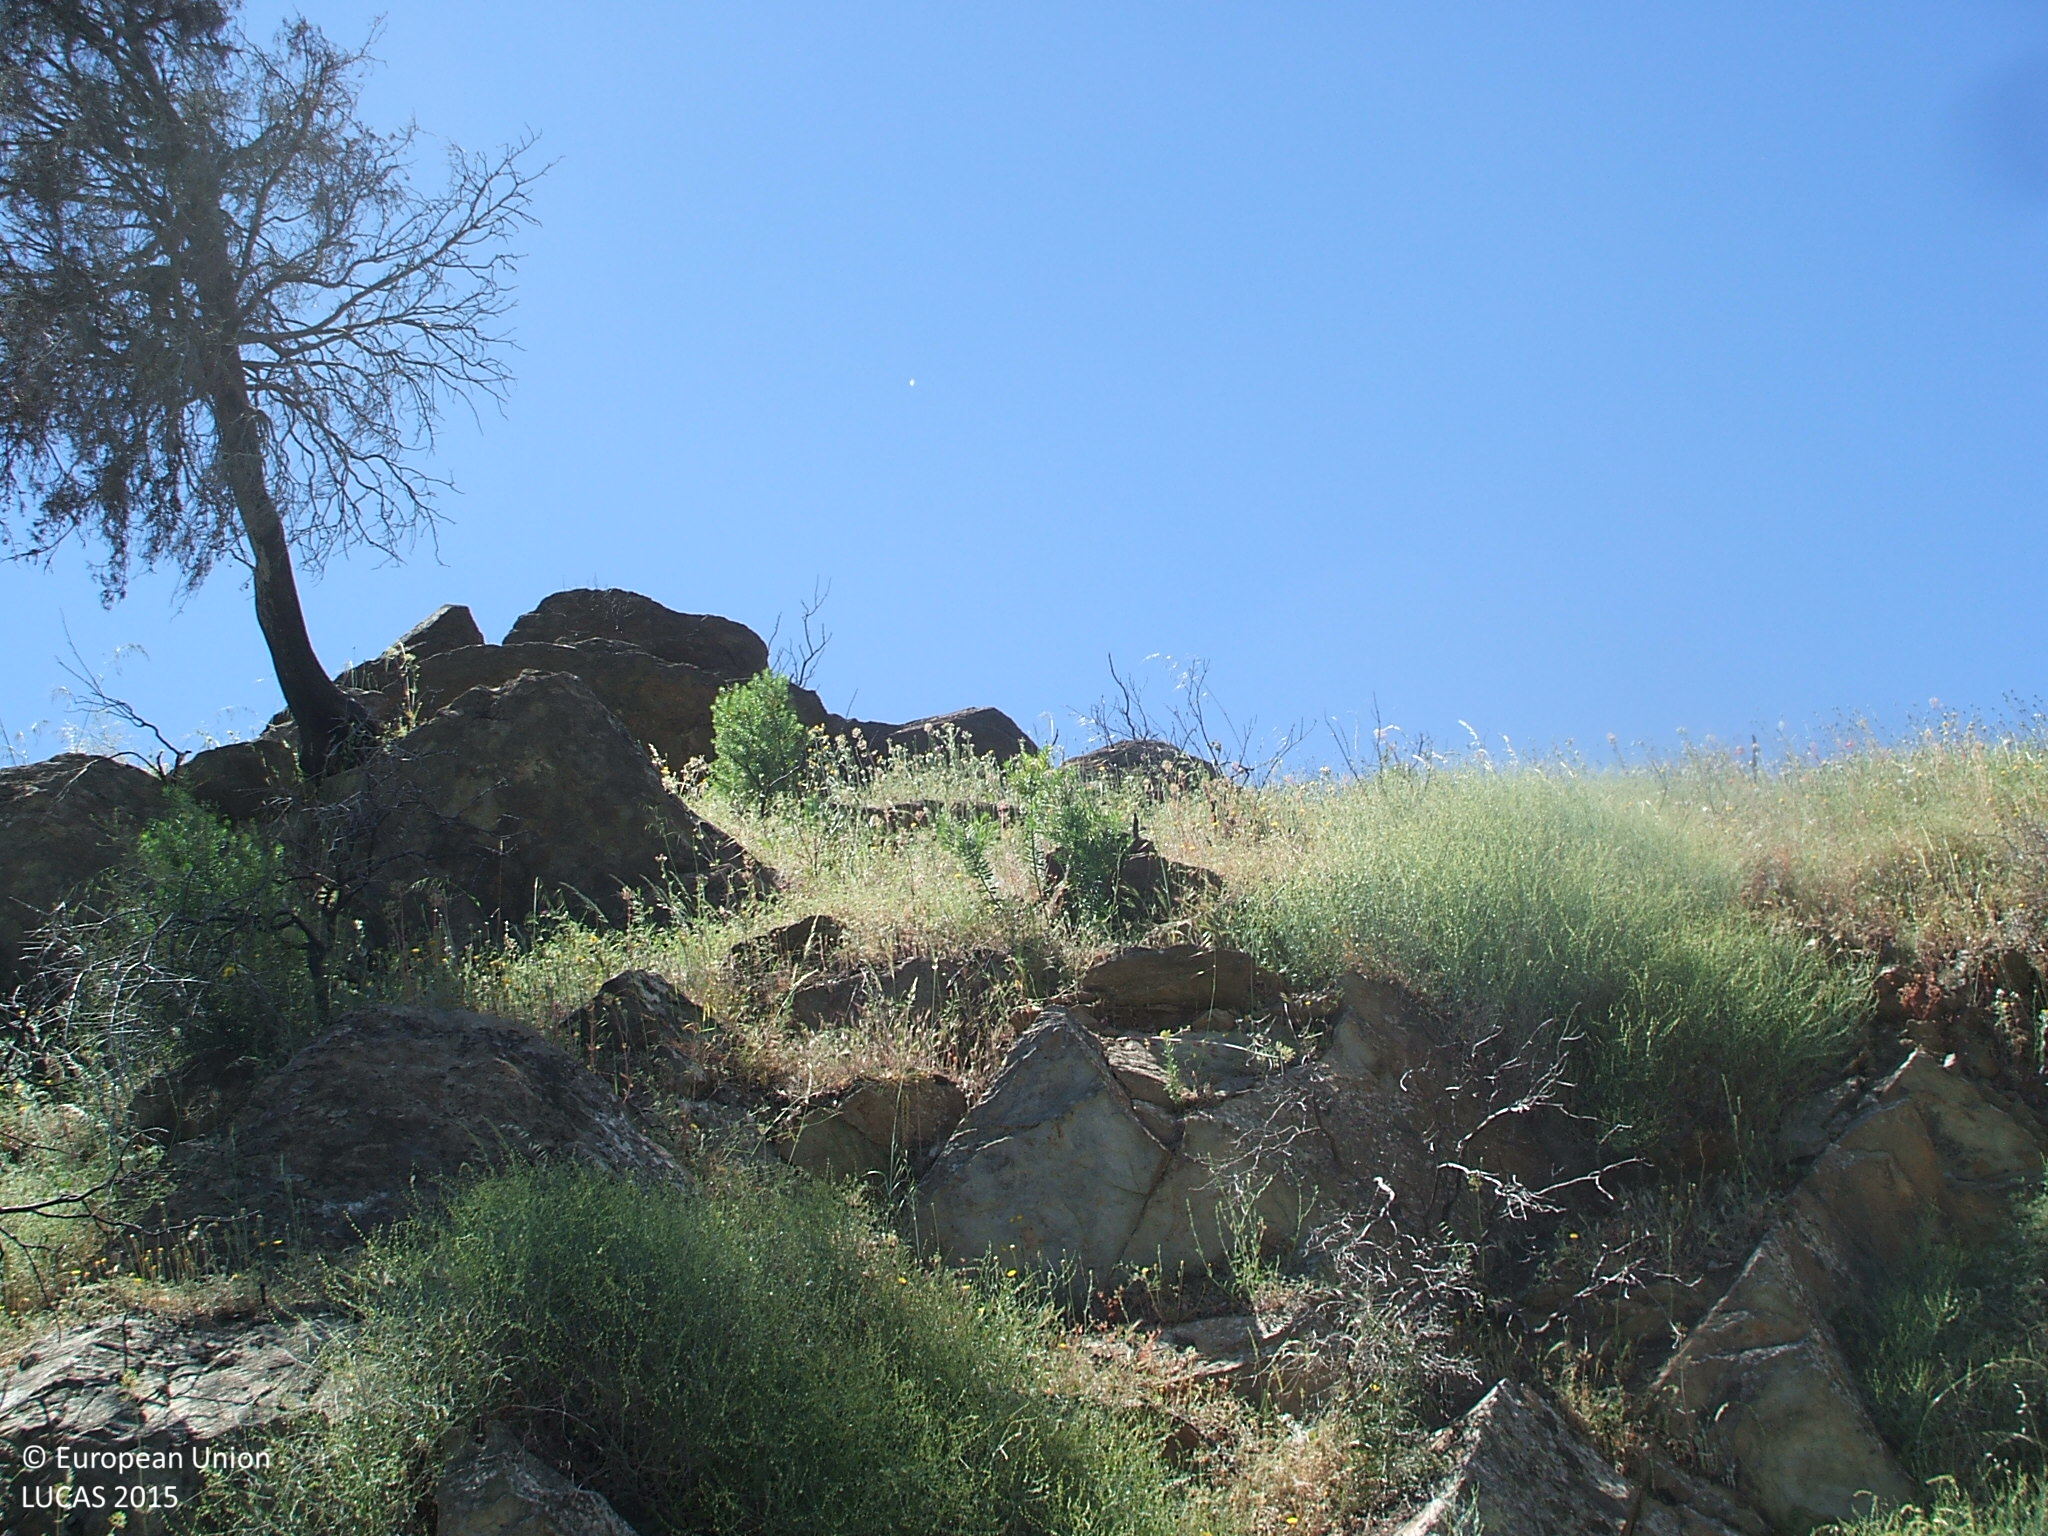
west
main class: Shrubland
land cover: Shrubland without tree cover
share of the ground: 10 - 25 %
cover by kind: consolidated bare surface 70 %, shrubs 15 %, herbaceous plants 15 %
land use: Semi-natural and natural areas not in use
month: May
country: ES
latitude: 40.9245
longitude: -3.3511
